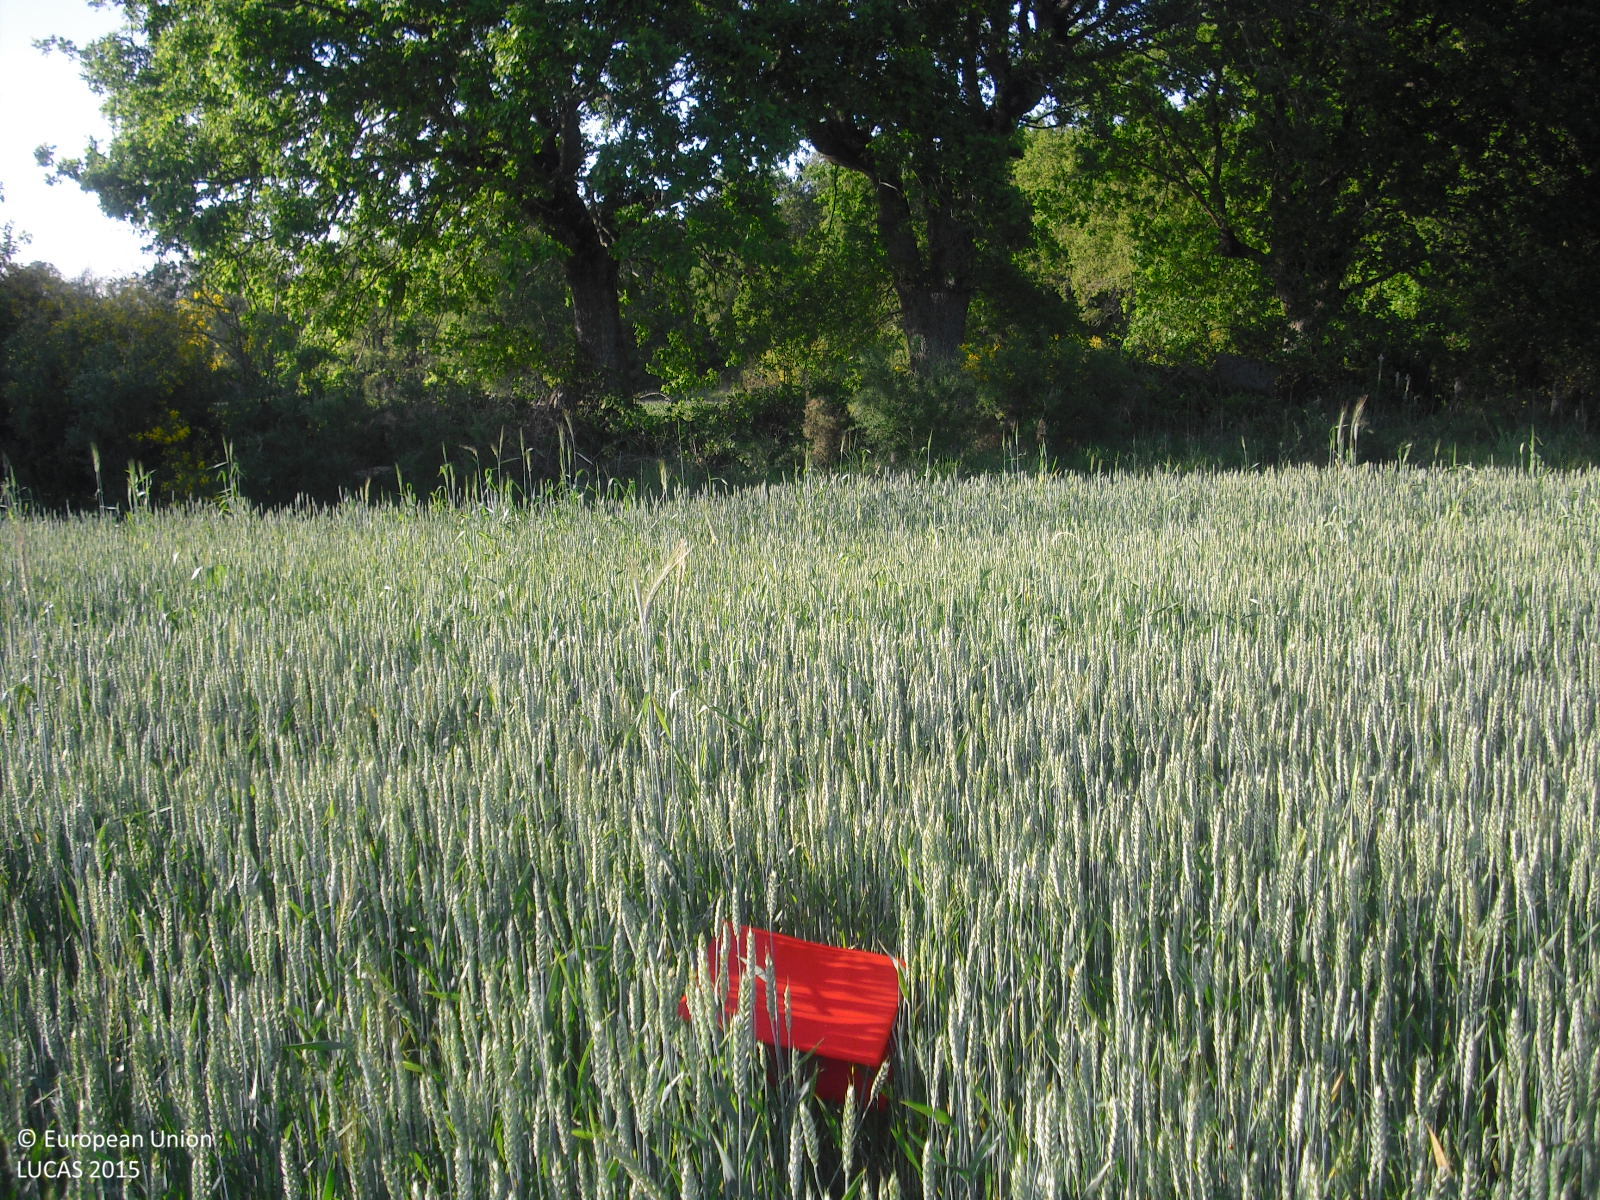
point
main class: Cropland
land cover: Common wheat
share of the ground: > 75 %
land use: Agriculture (excluding fallow land and kitchen gardens)
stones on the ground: < 10 %
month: May
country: ES
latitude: 42.0666
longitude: -7.6517
